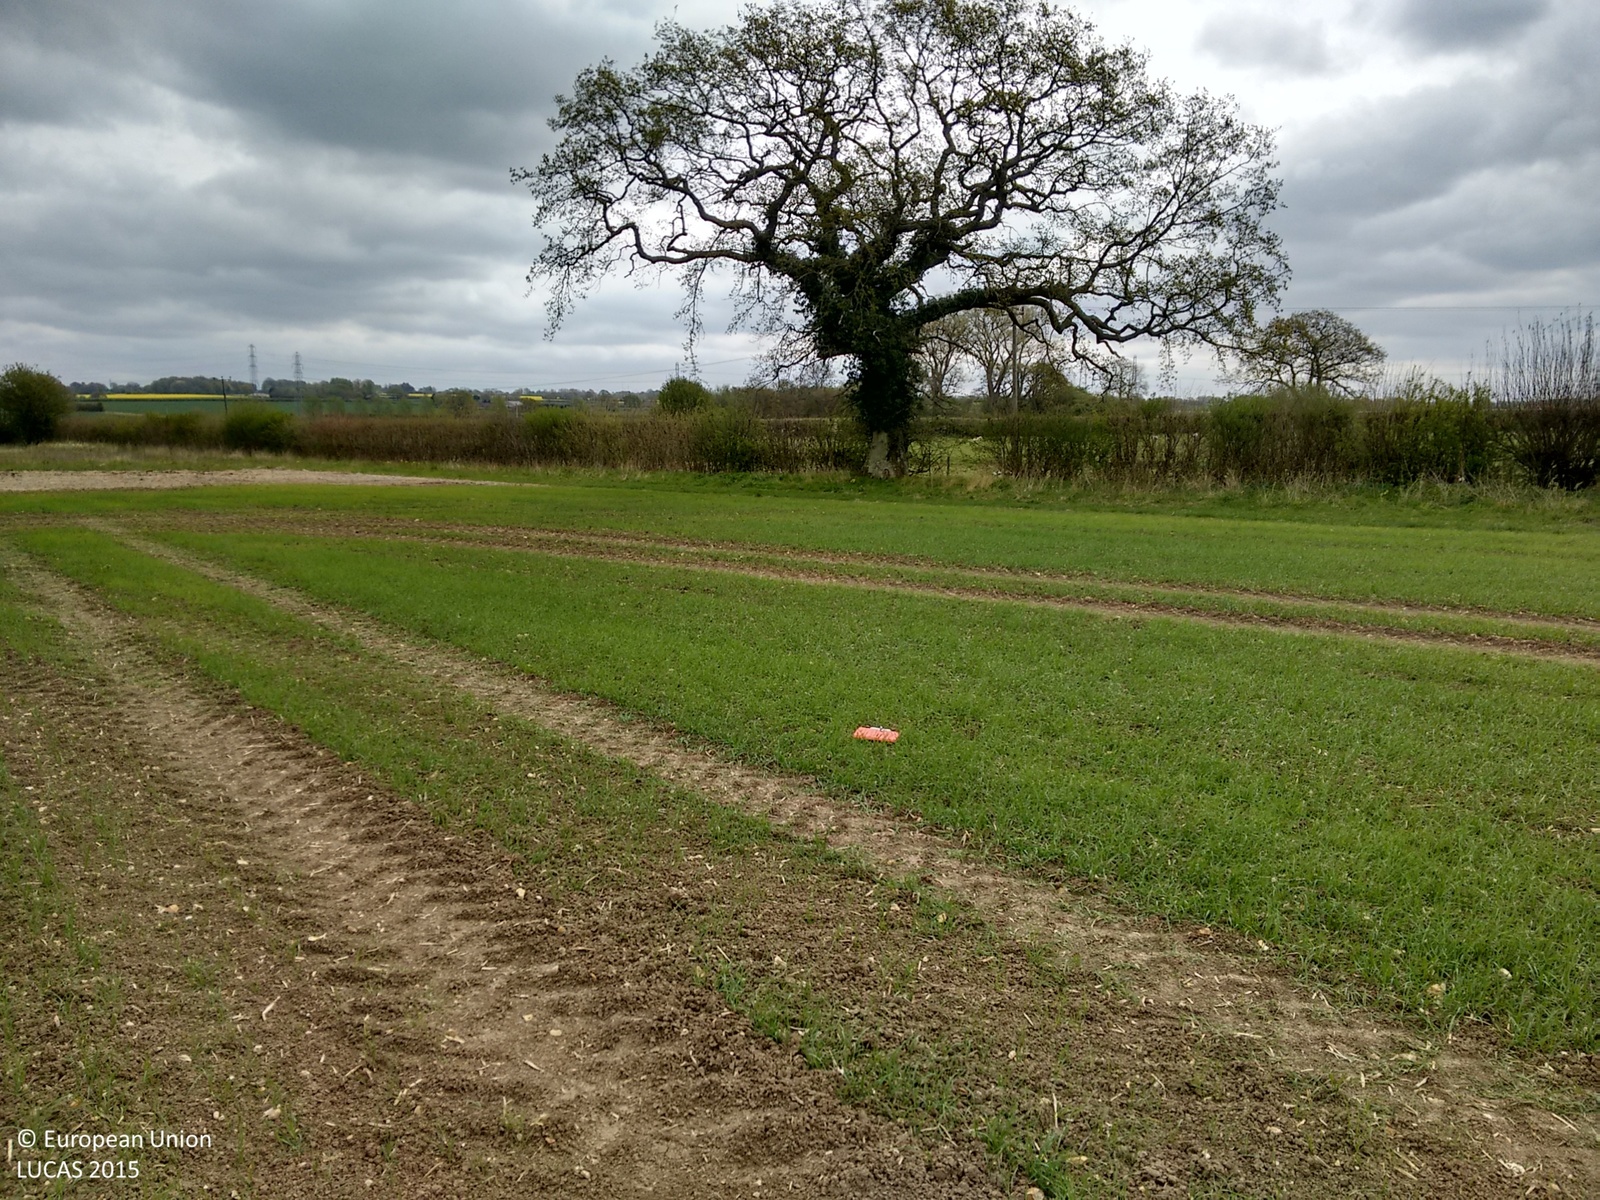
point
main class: Cropland
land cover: Common wheat
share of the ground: 50 - 75 %
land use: Agriculture (excluding fallow land and kitchen gardens)
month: May
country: GB
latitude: 51.1229
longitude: -0.9741
